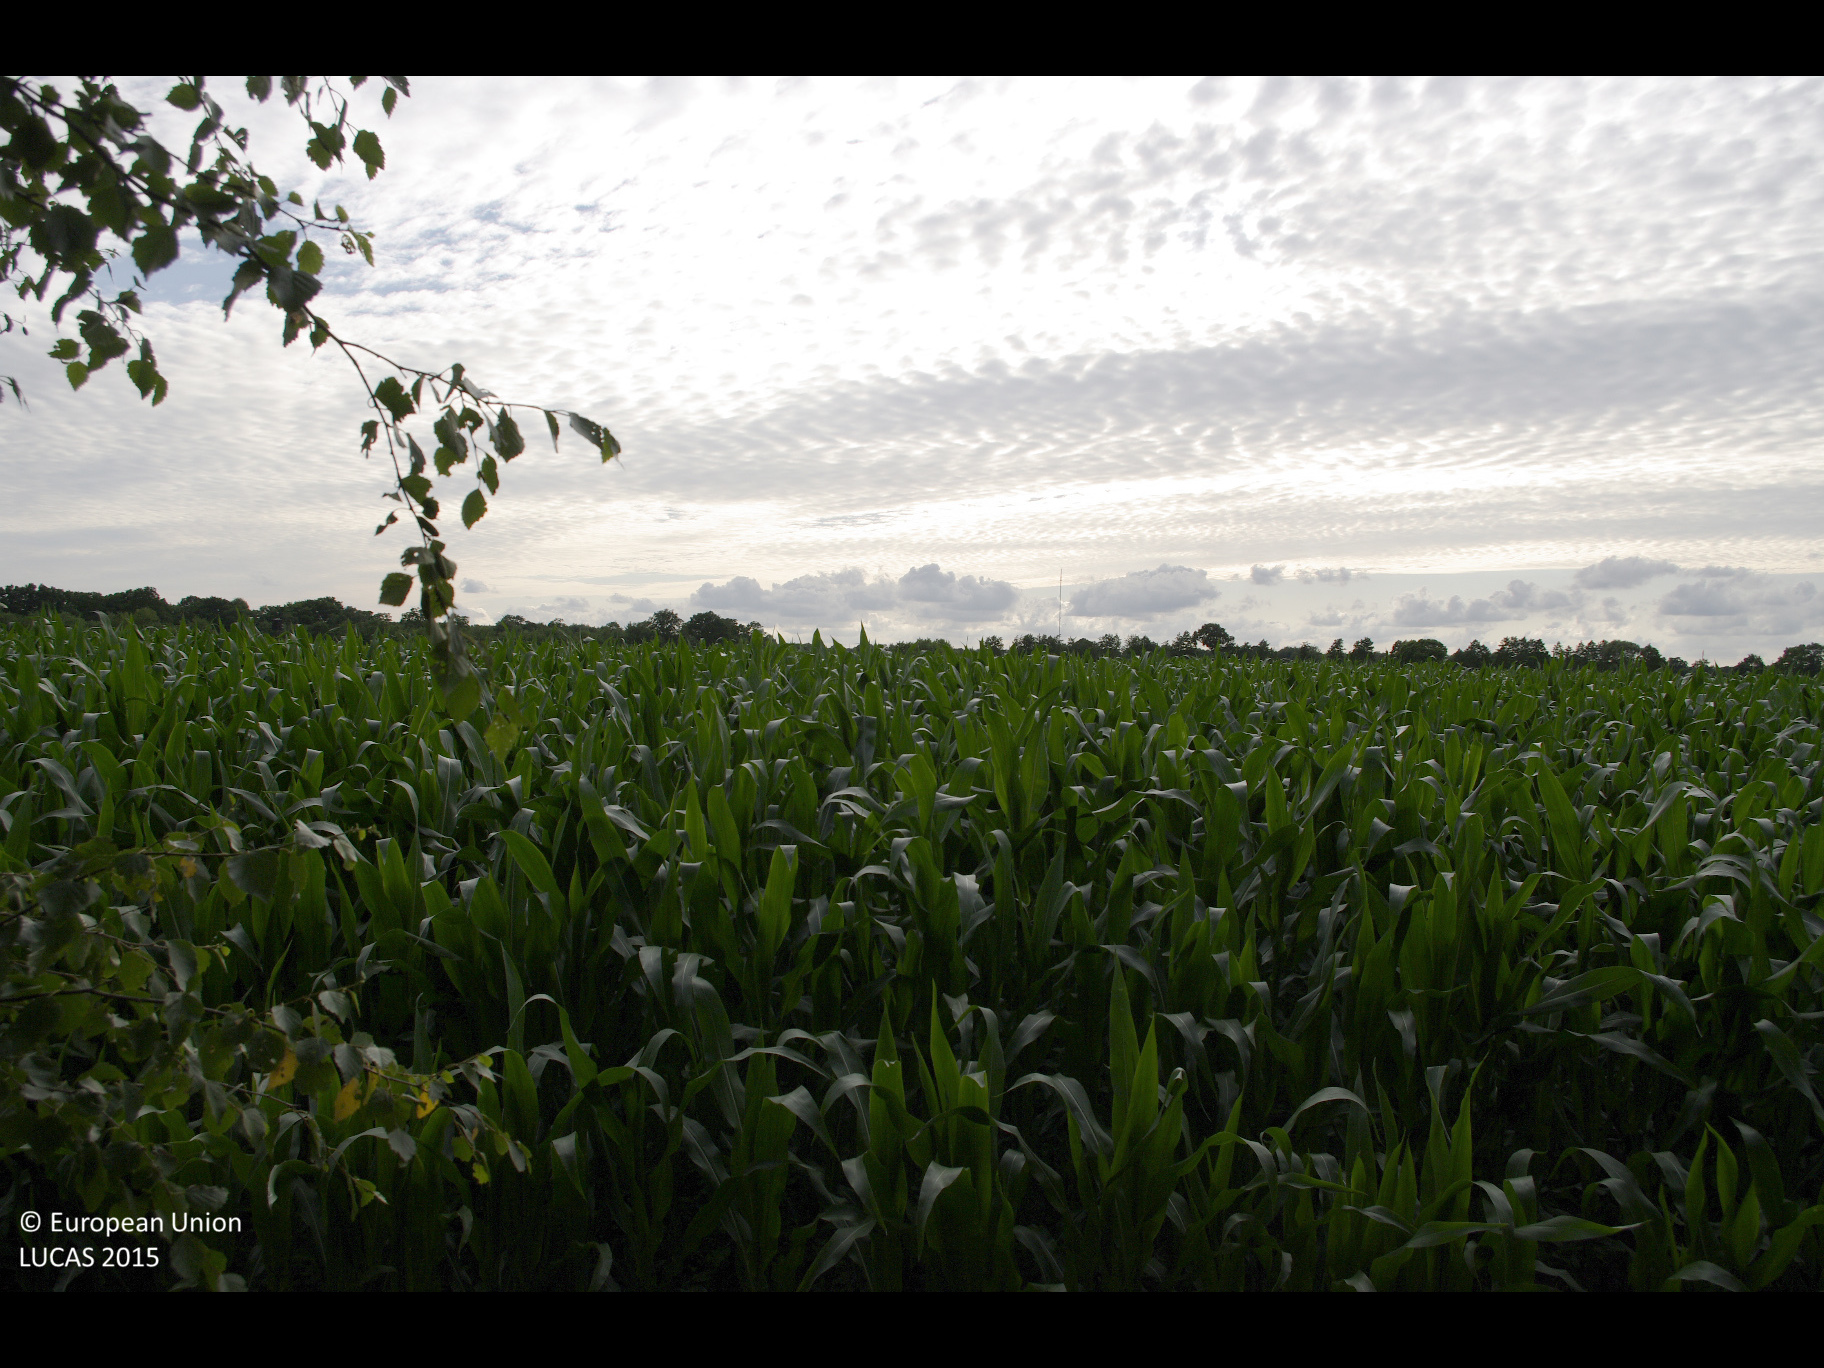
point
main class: Cropland
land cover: Maize
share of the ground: > 75 %
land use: Agriculture (excluding fallow land and kitchen gardens)
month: July
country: DE
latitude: 53.9770
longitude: 9.8933
